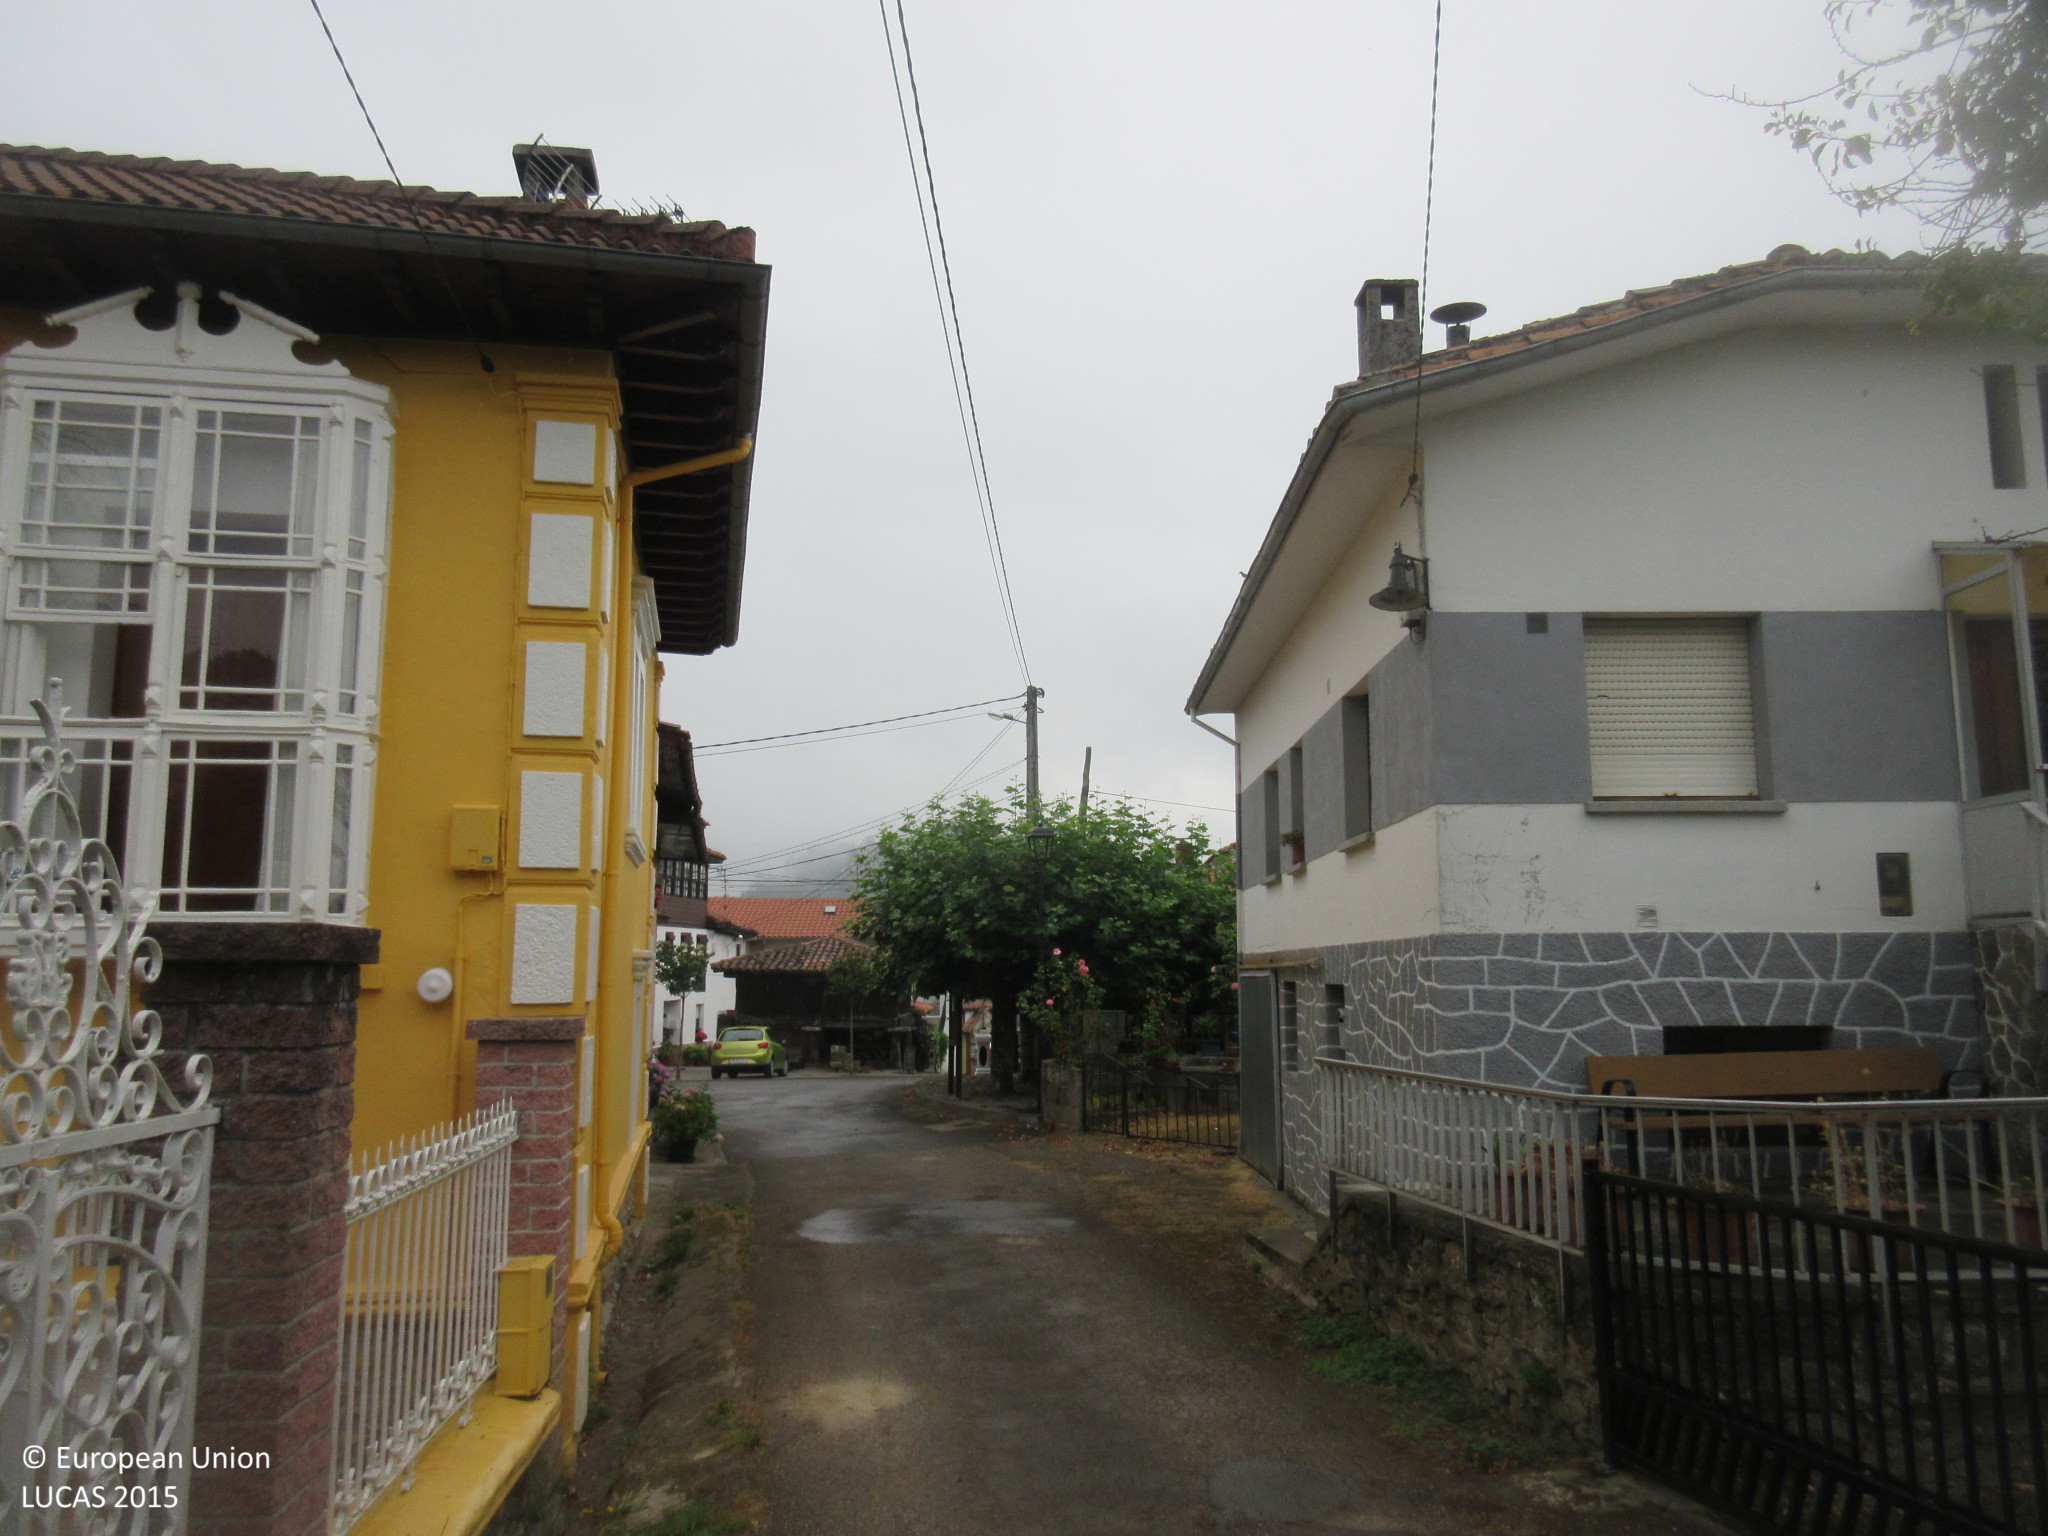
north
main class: Grassland
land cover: Grassland with sparse tree/shrub cover
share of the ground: > 75 %
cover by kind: herbaceous plants 95 %, broadleaved forest trees 5 %
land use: Residential
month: July
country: ES
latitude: 43.3600
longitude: -5.2644
